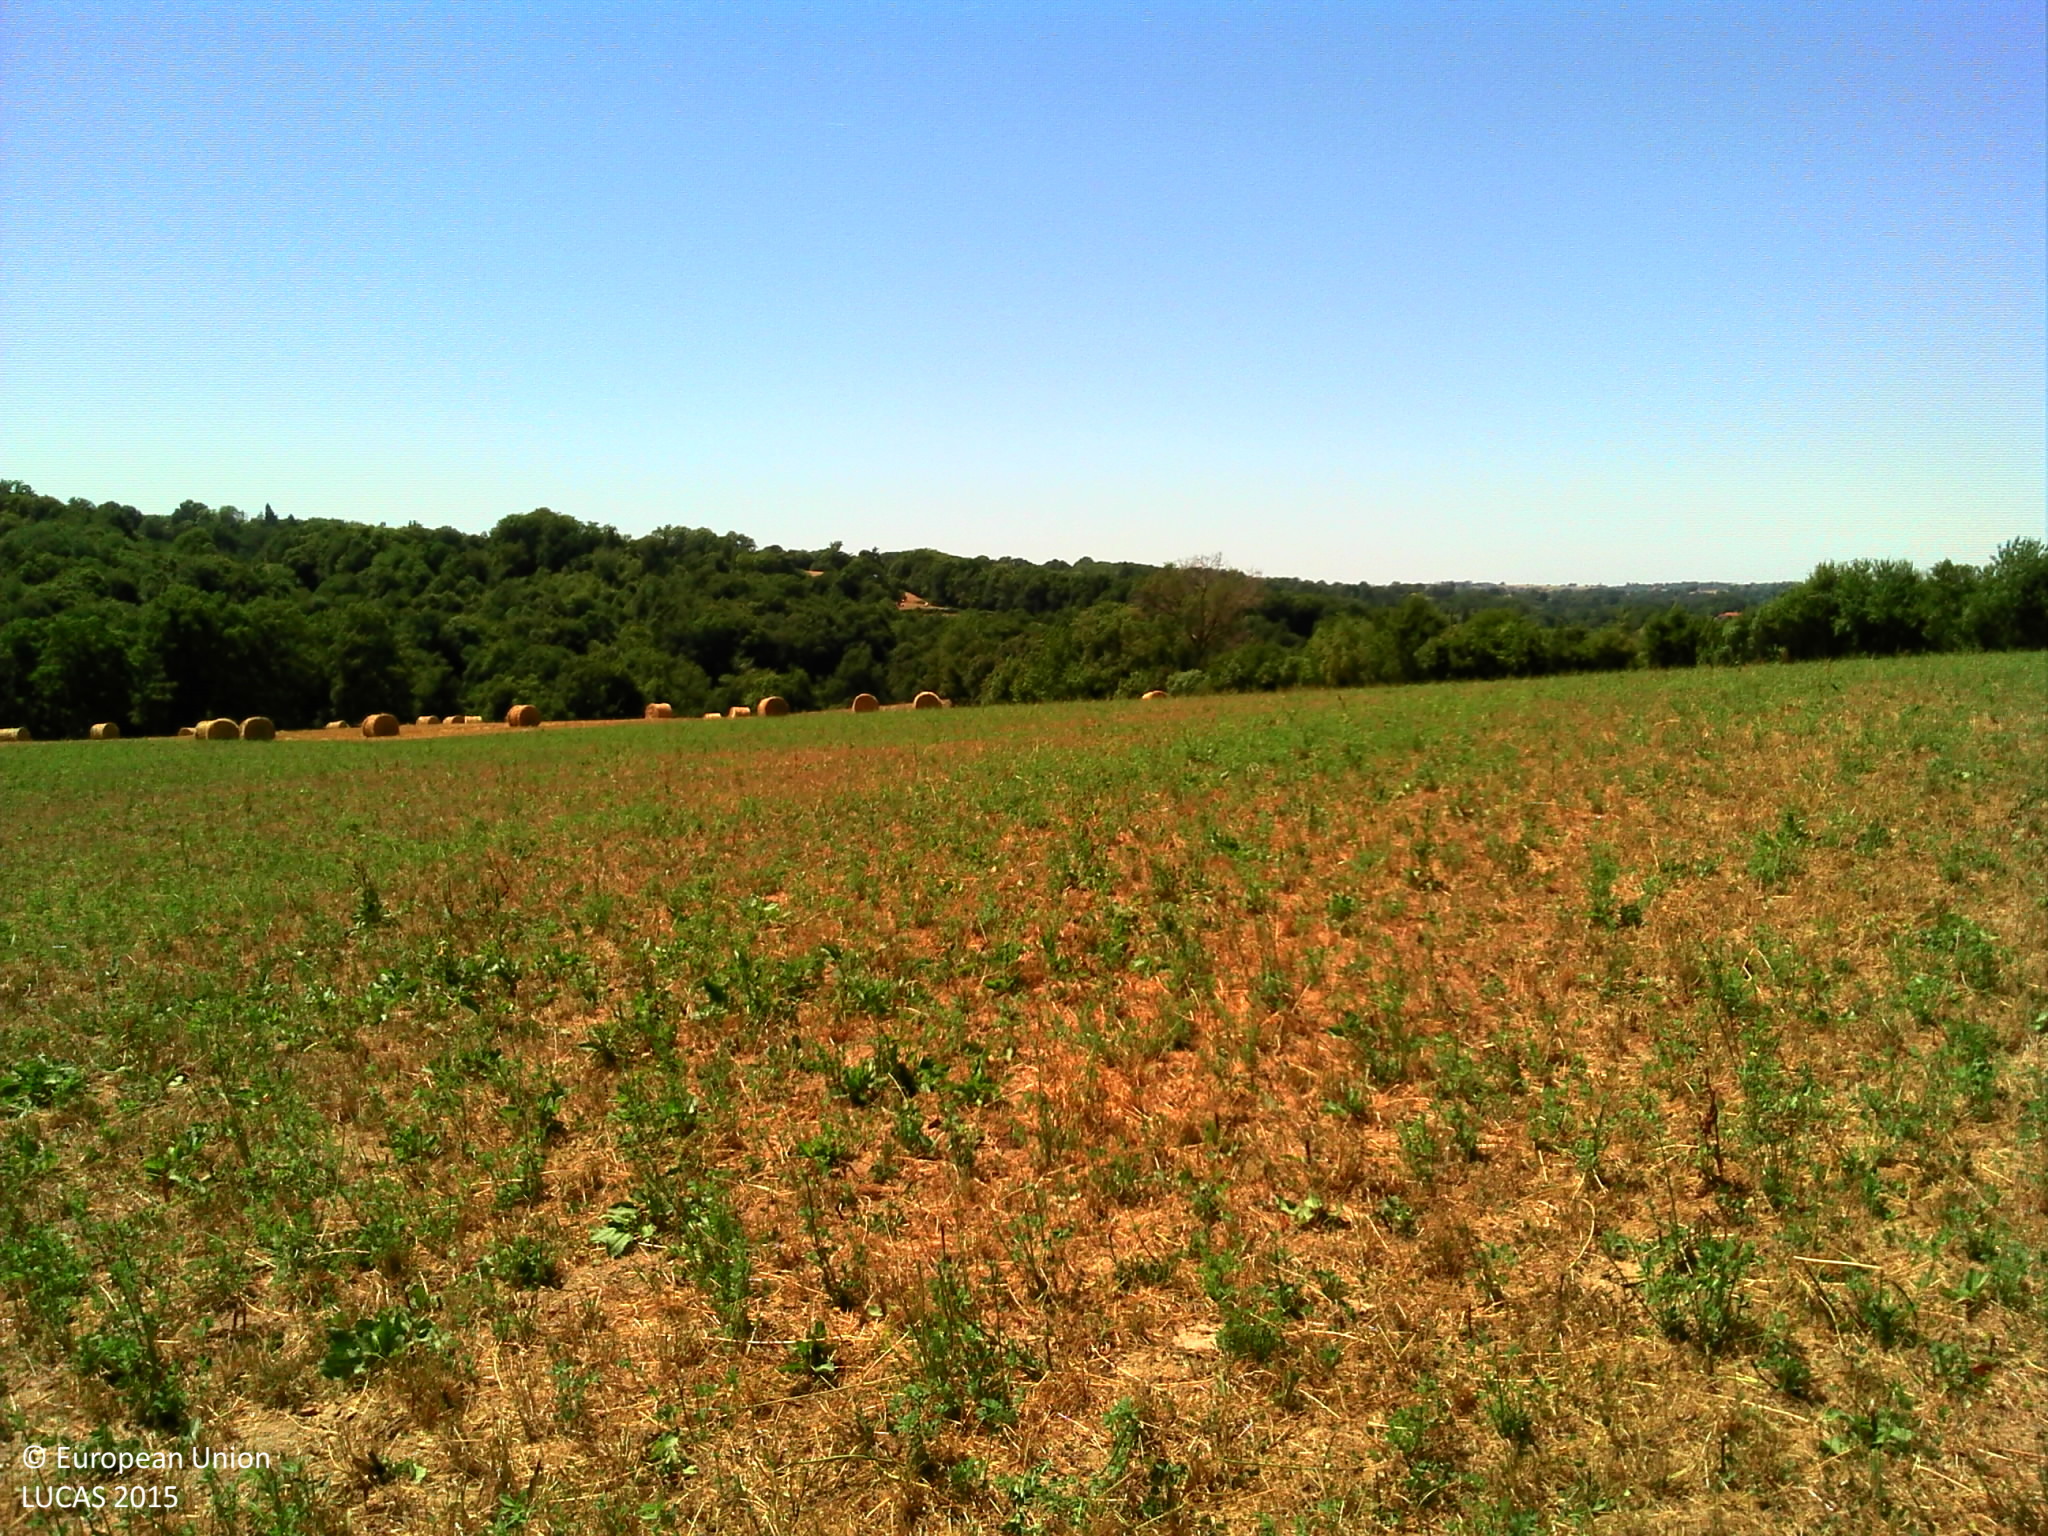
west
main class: Grassland
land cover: Grassland without tree/shrub cover
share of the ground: > 75 %
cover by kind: herbaceous plants 95 %
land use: Agriculture (excluding fallow land and kitchen gardens)
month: July
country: FR
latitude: 45.7185
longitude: 1.4489
